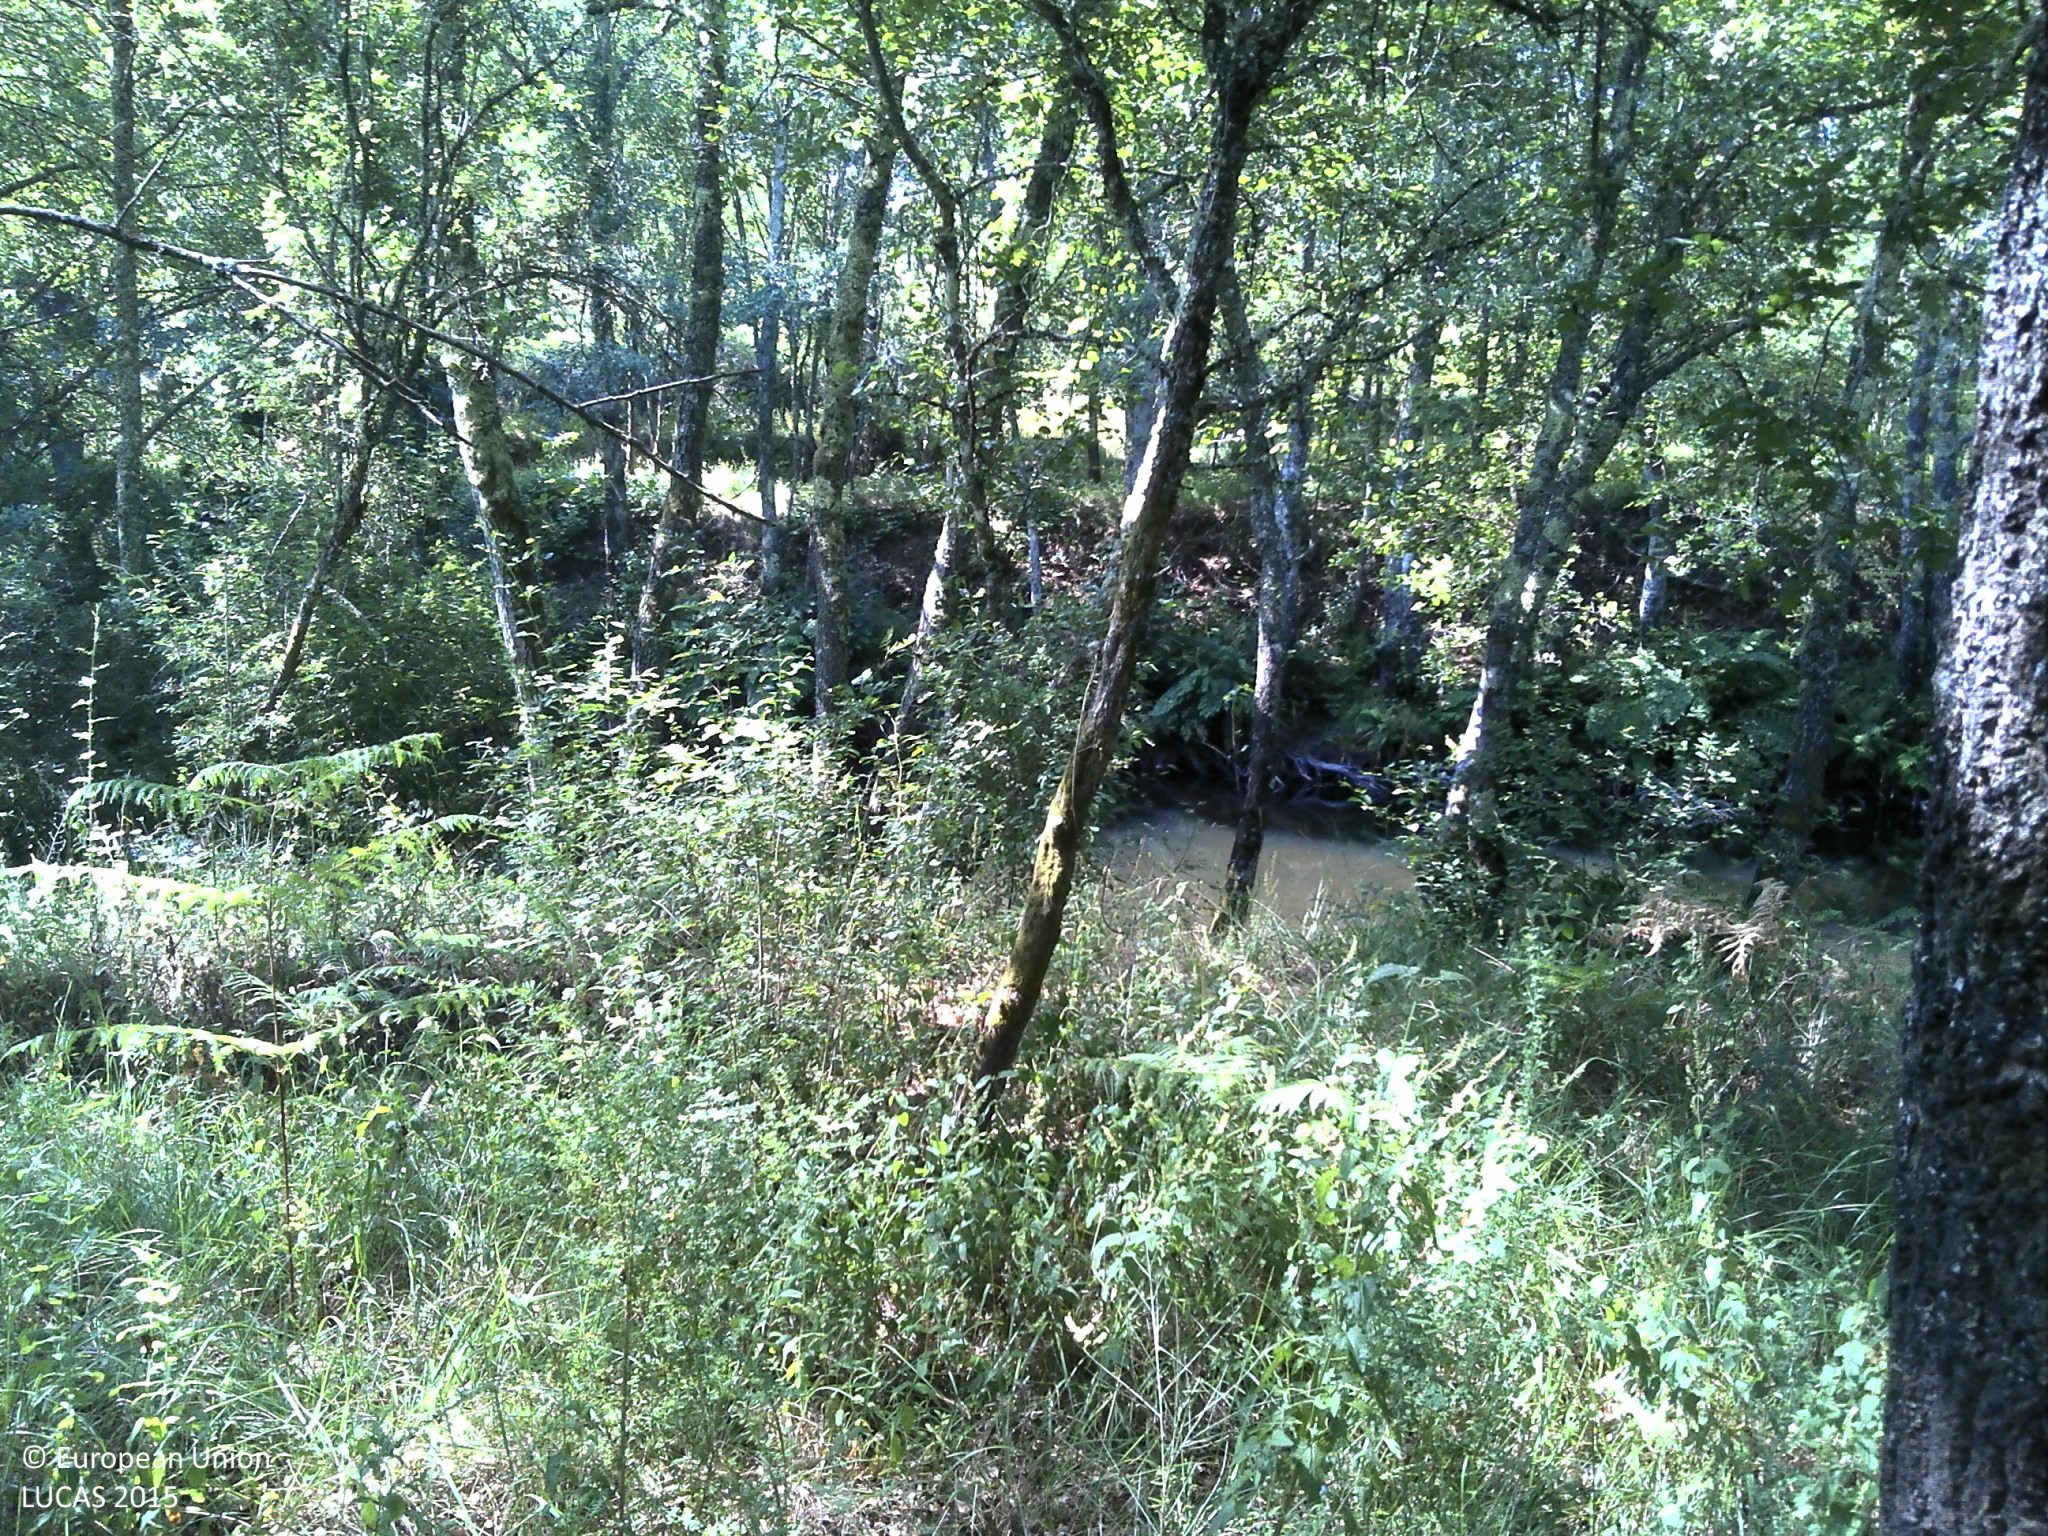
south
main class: Woodland
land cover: Broadleaved woodland
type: thermophilous deciduous forest
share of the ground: 10 - 25 %
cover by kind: shrubs 40 %, broadleaved forest trees 20 %, herbaceous plants 20 %, unconsolidated bare surface 20 %
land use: Forestry
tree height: > 5 m
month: July
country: PT
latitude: 40.7566
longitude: -7.8566
